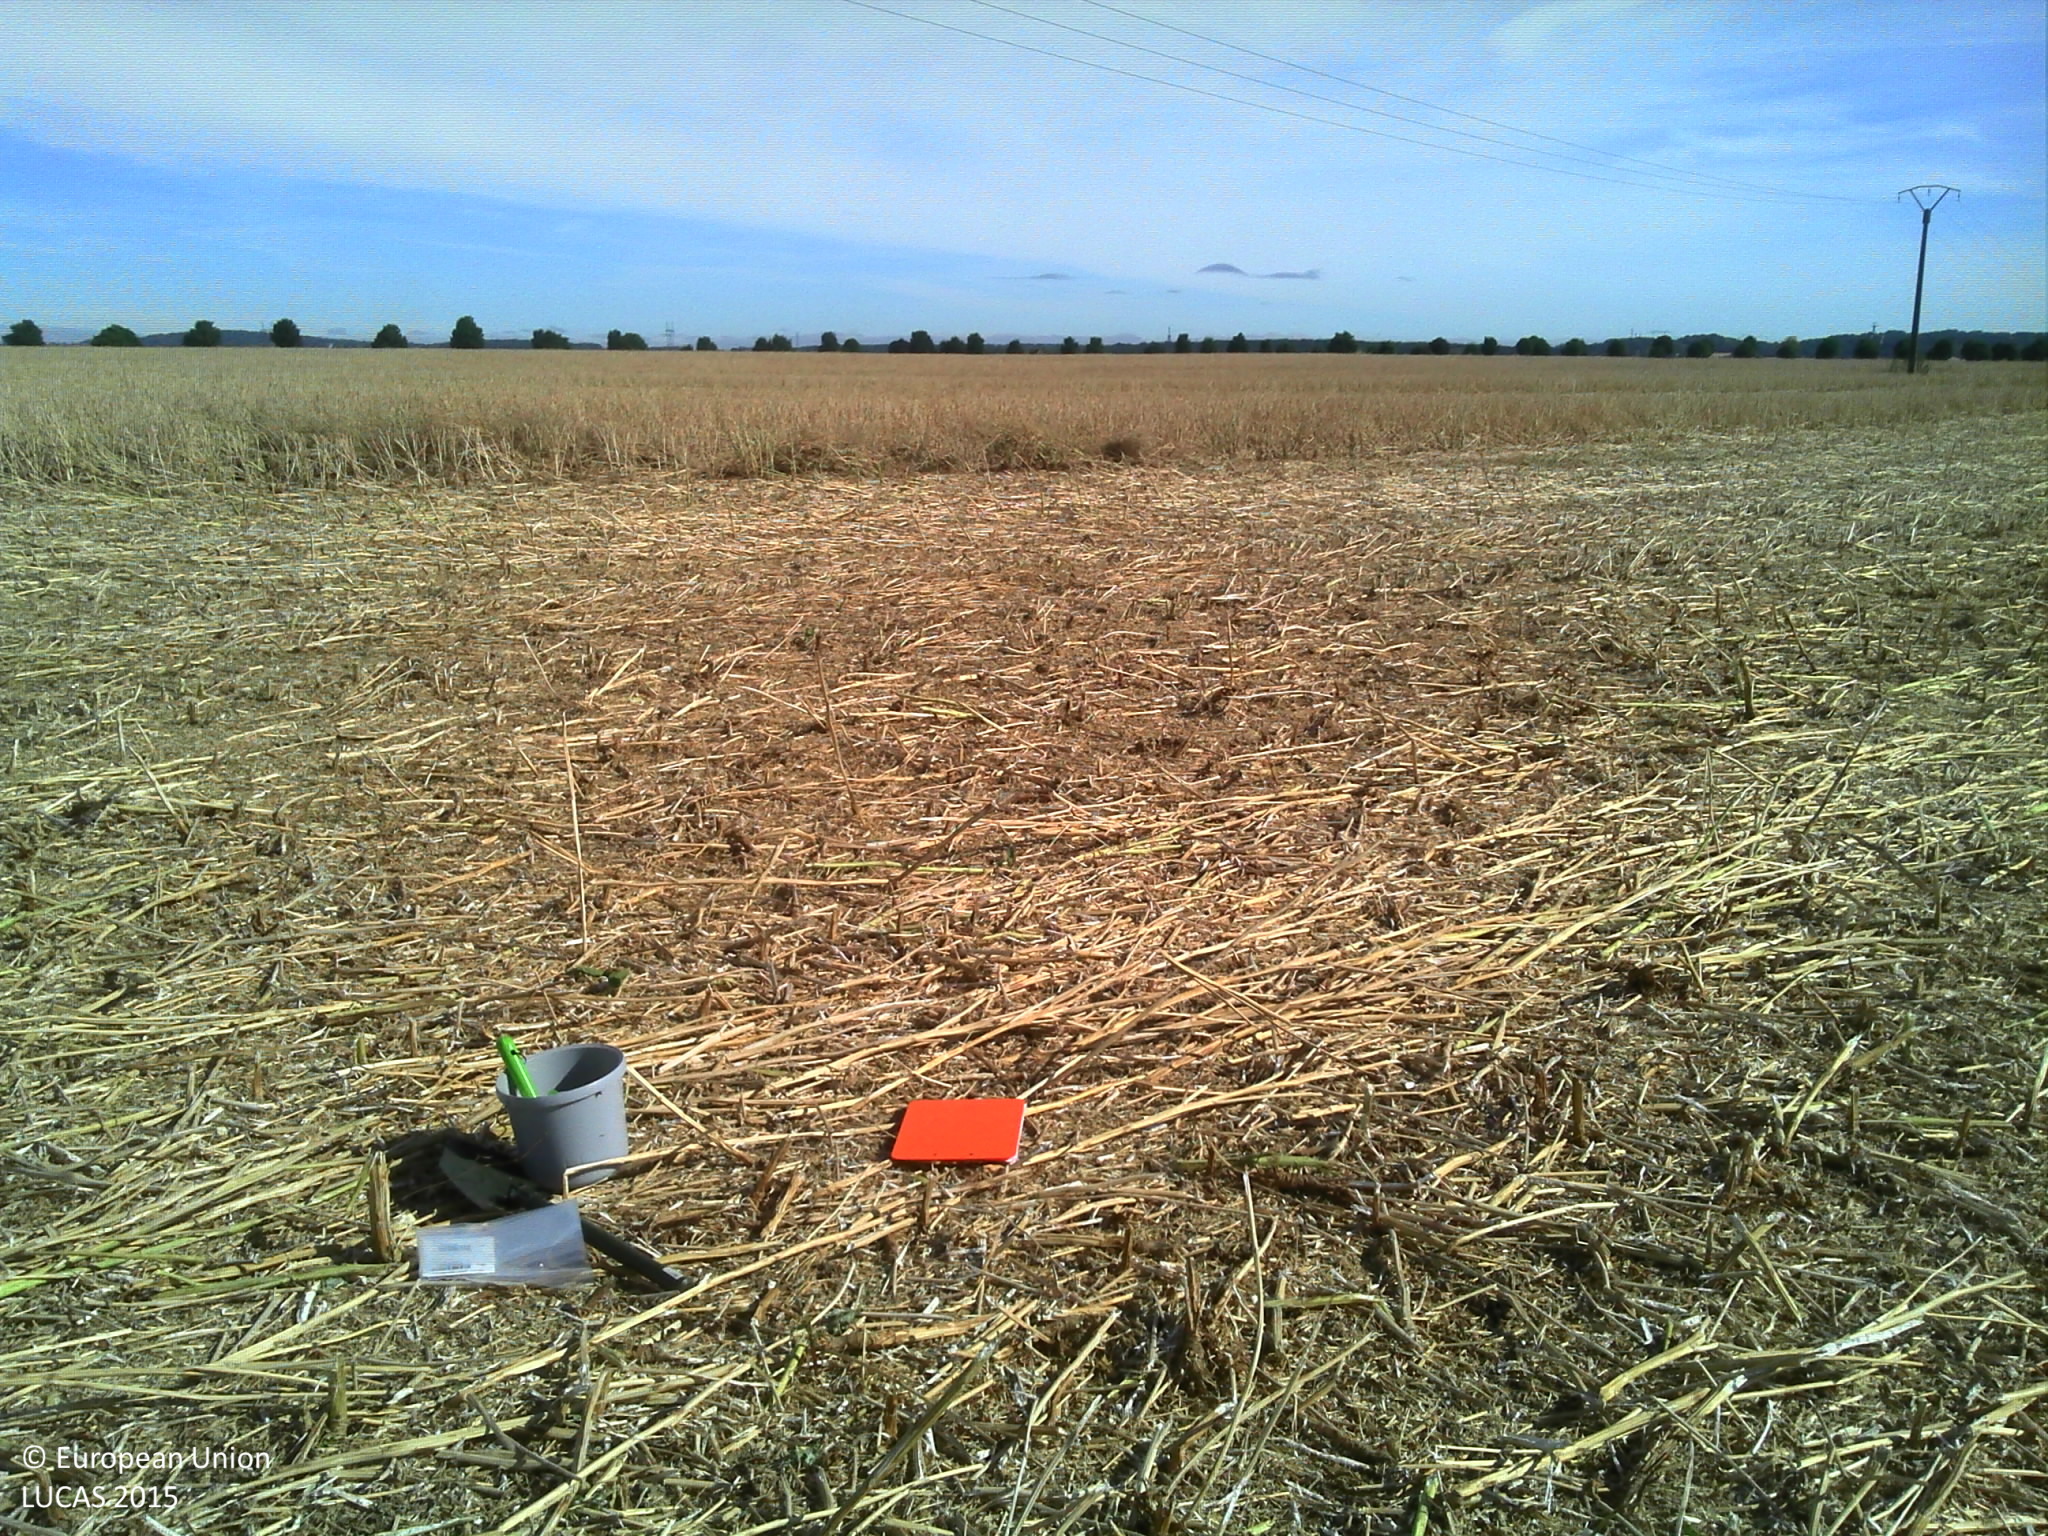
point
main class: Cropland
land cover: Rape and turnip rape
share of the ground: 10 - 25 %
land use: Agriculture (excluding fallow land and kitchen gardens)
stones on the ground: < 10 %
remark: Harvested field
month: August
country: FR
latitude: 49.0237
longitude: 2.6181
